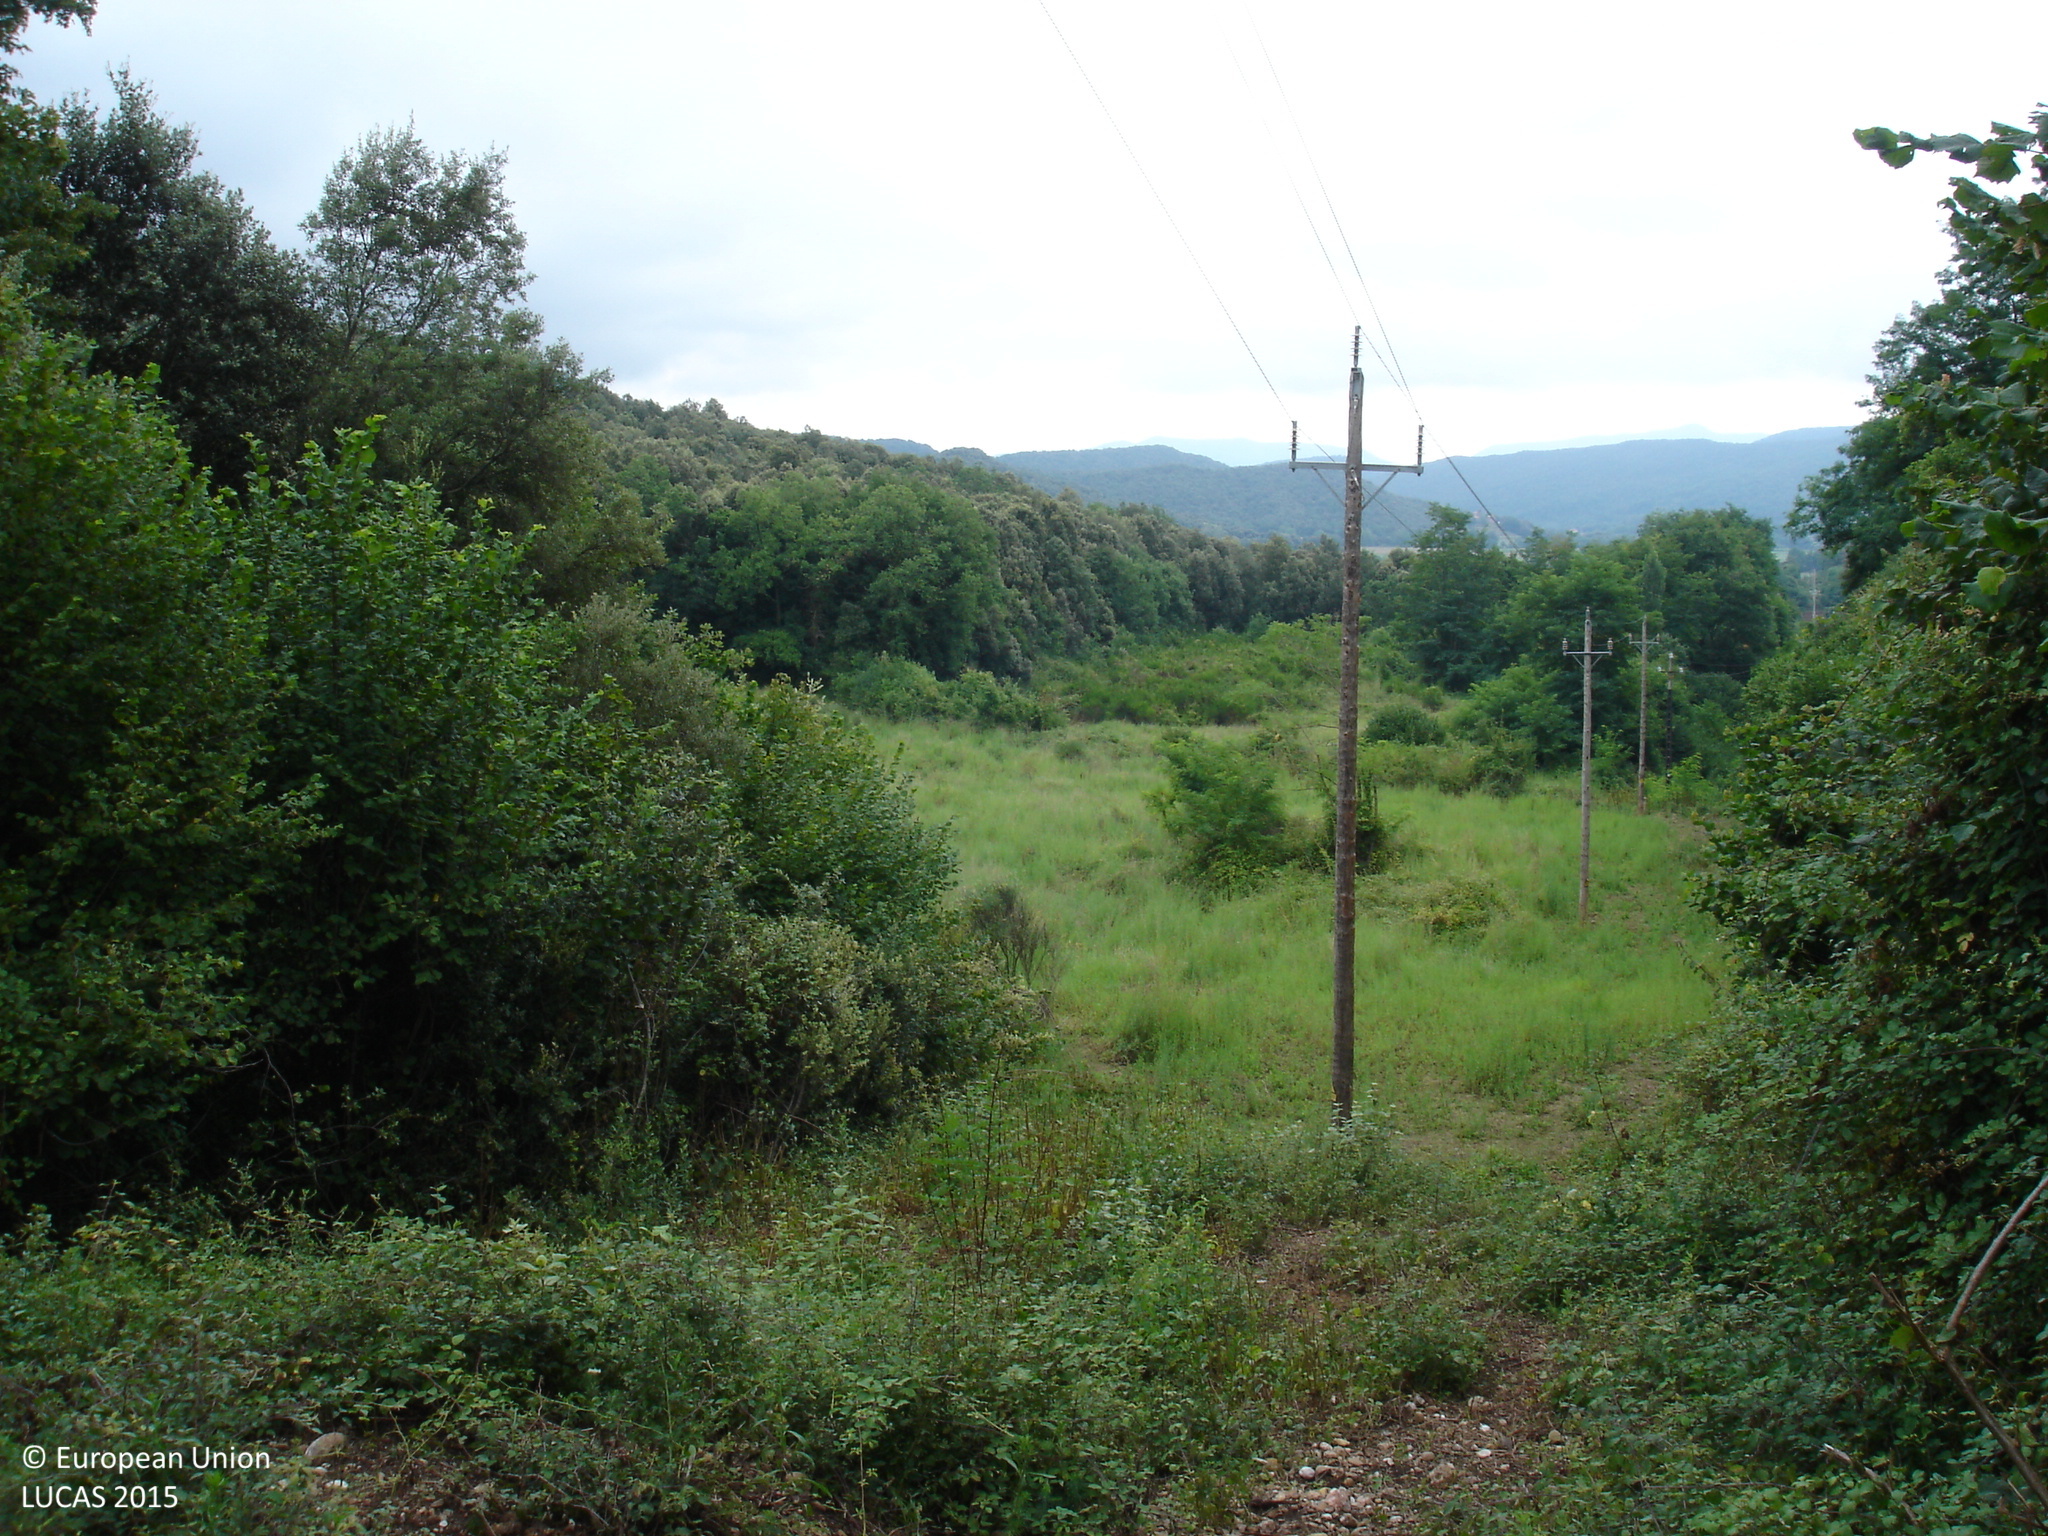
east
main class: Woodland
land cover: Broadleaved woodland
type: thermophilous deciduous forest
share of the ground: > 75 %
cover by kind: broadleaved forest trees 80 %, shrubs 20 %
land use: Forestry
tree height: > 5 m
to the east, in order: Broadleaved woodland; Electric lines; Broadleaved woodland; Spontaneously vegetated surfaces; Electric lines; Grassland with sparse tree/shrub cover; Shrubland without tree cover; Shrubland with sparse tree cover
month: July
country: ES
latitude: 42.1616
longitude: 2.5463
